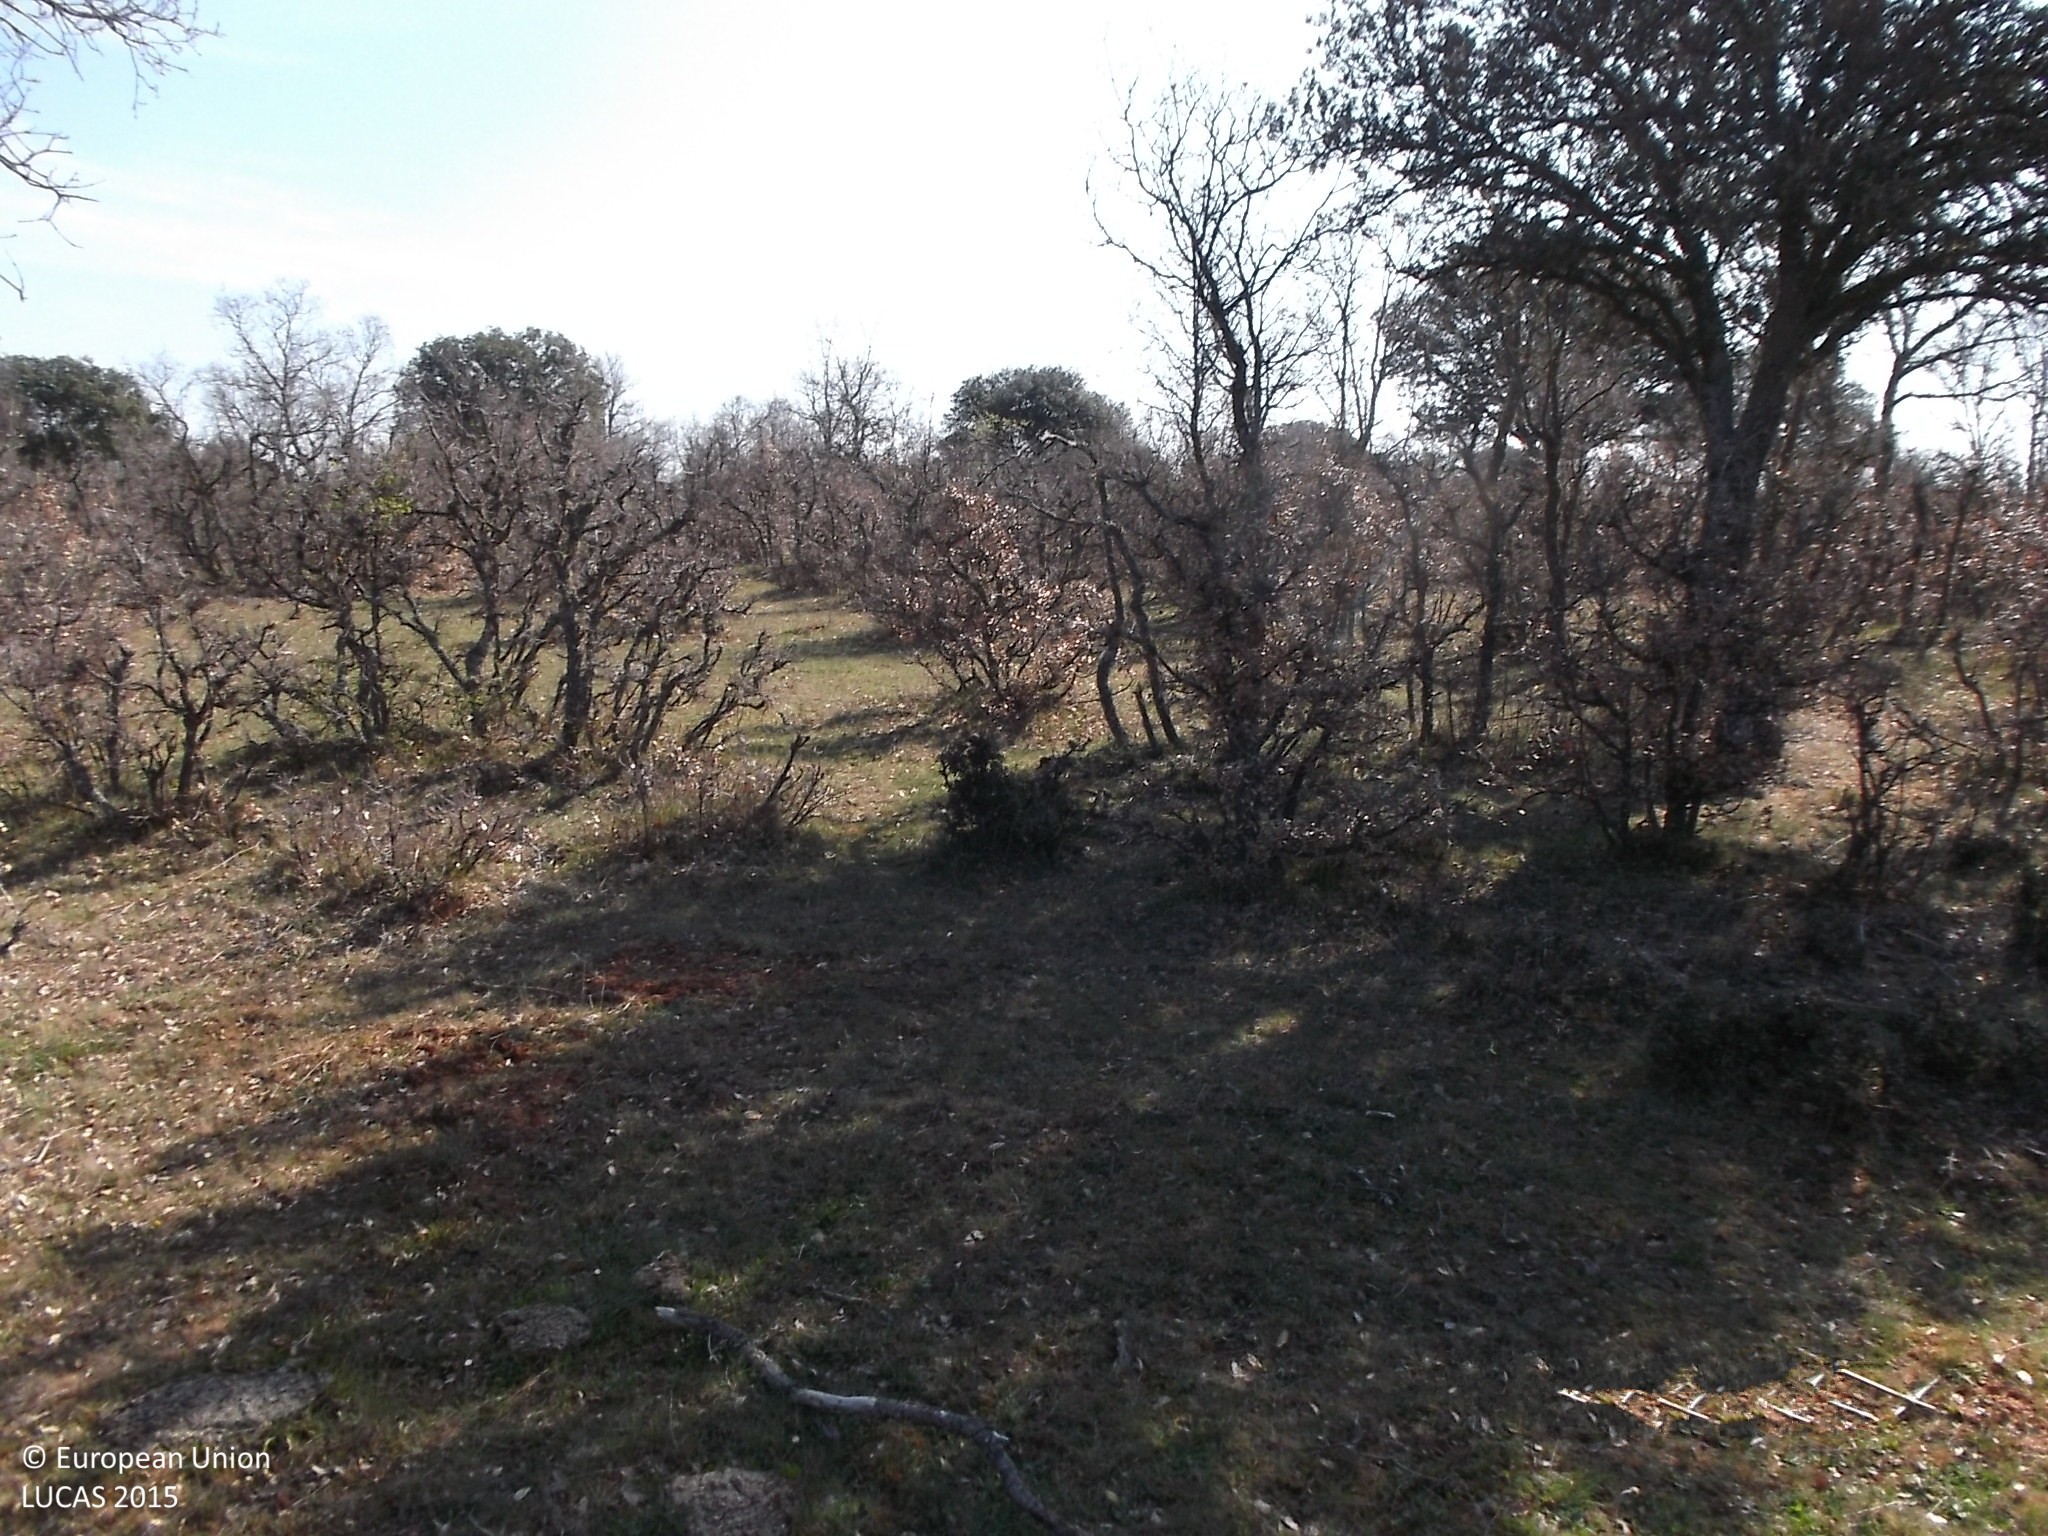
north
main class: Woodland
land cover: Broadleaved woodland
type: broadleaved evergreen forest
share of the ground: 25 - 50 %
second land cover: Grassland without tree/shrub cover
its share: 50 - 75 %
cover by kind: broadleaved forest trees 50 %, herbaceous plants 50 %
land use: Forestry
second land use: Agriculture (excluding fallow land and kitchen gardens)
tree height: < 5 m
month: April
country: ES
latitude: 40.8782
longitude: -5.8747
